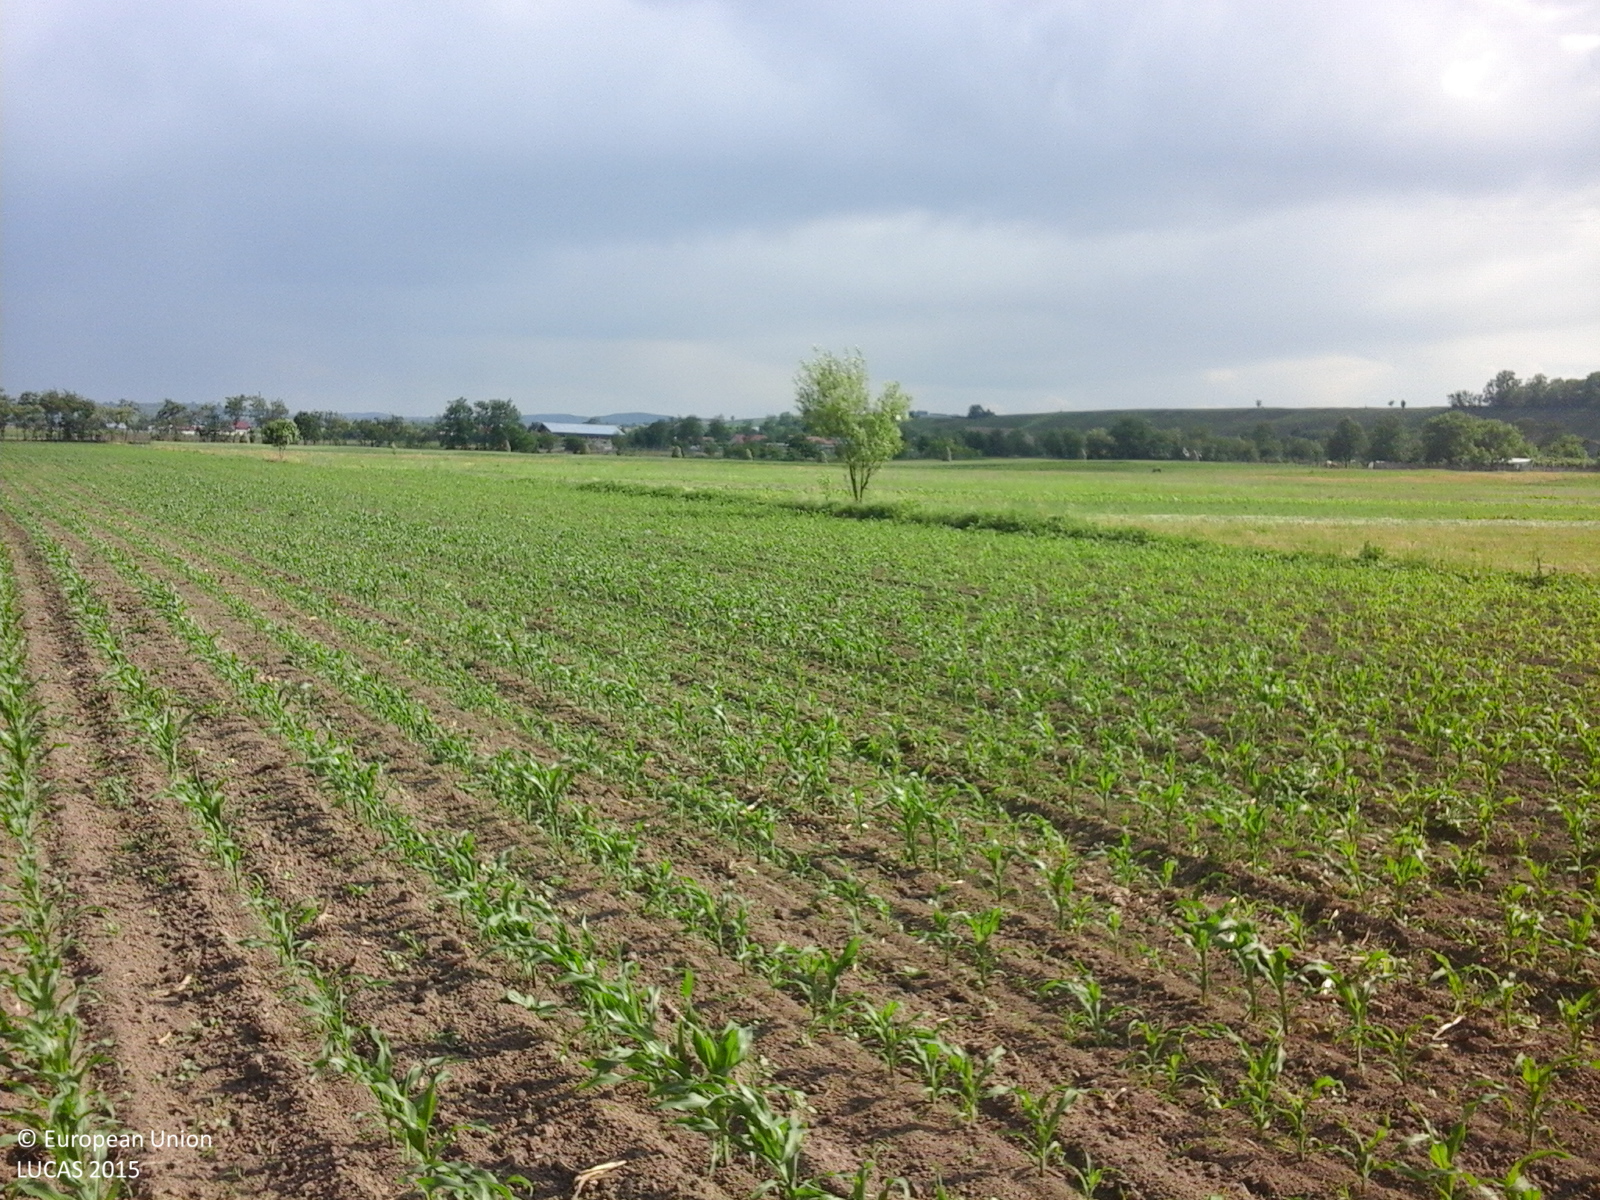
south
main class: Cropland
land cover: Maize
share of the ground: 10 - 25 %
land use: Agriculture (excluding fallow land and kitchen gardens)
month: June
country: RO
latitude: 46.7736
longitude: 26.5739
